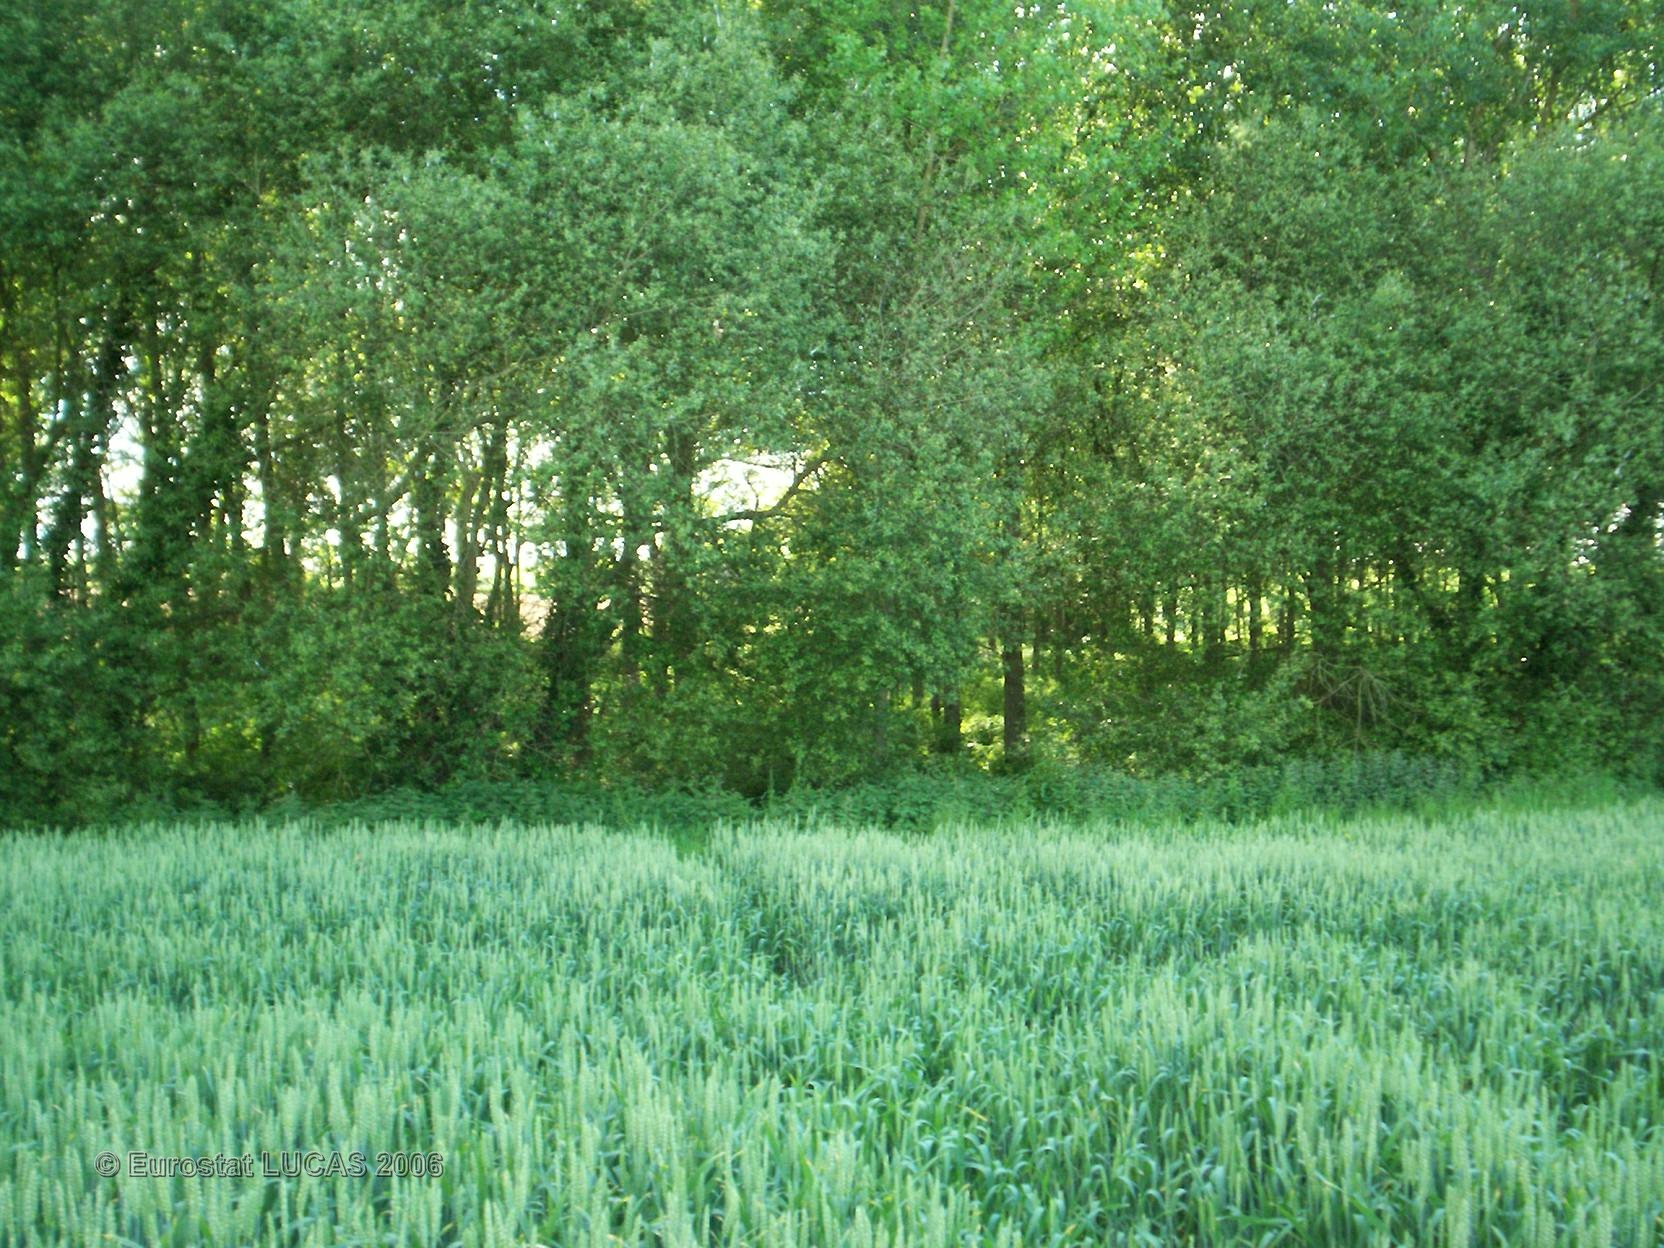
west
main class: Cropland
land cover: Common wheat
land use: Agriculture (excluding fallow land and kitchen gardens)
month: May
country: FR
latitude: 48.4482
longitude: -2.4037
